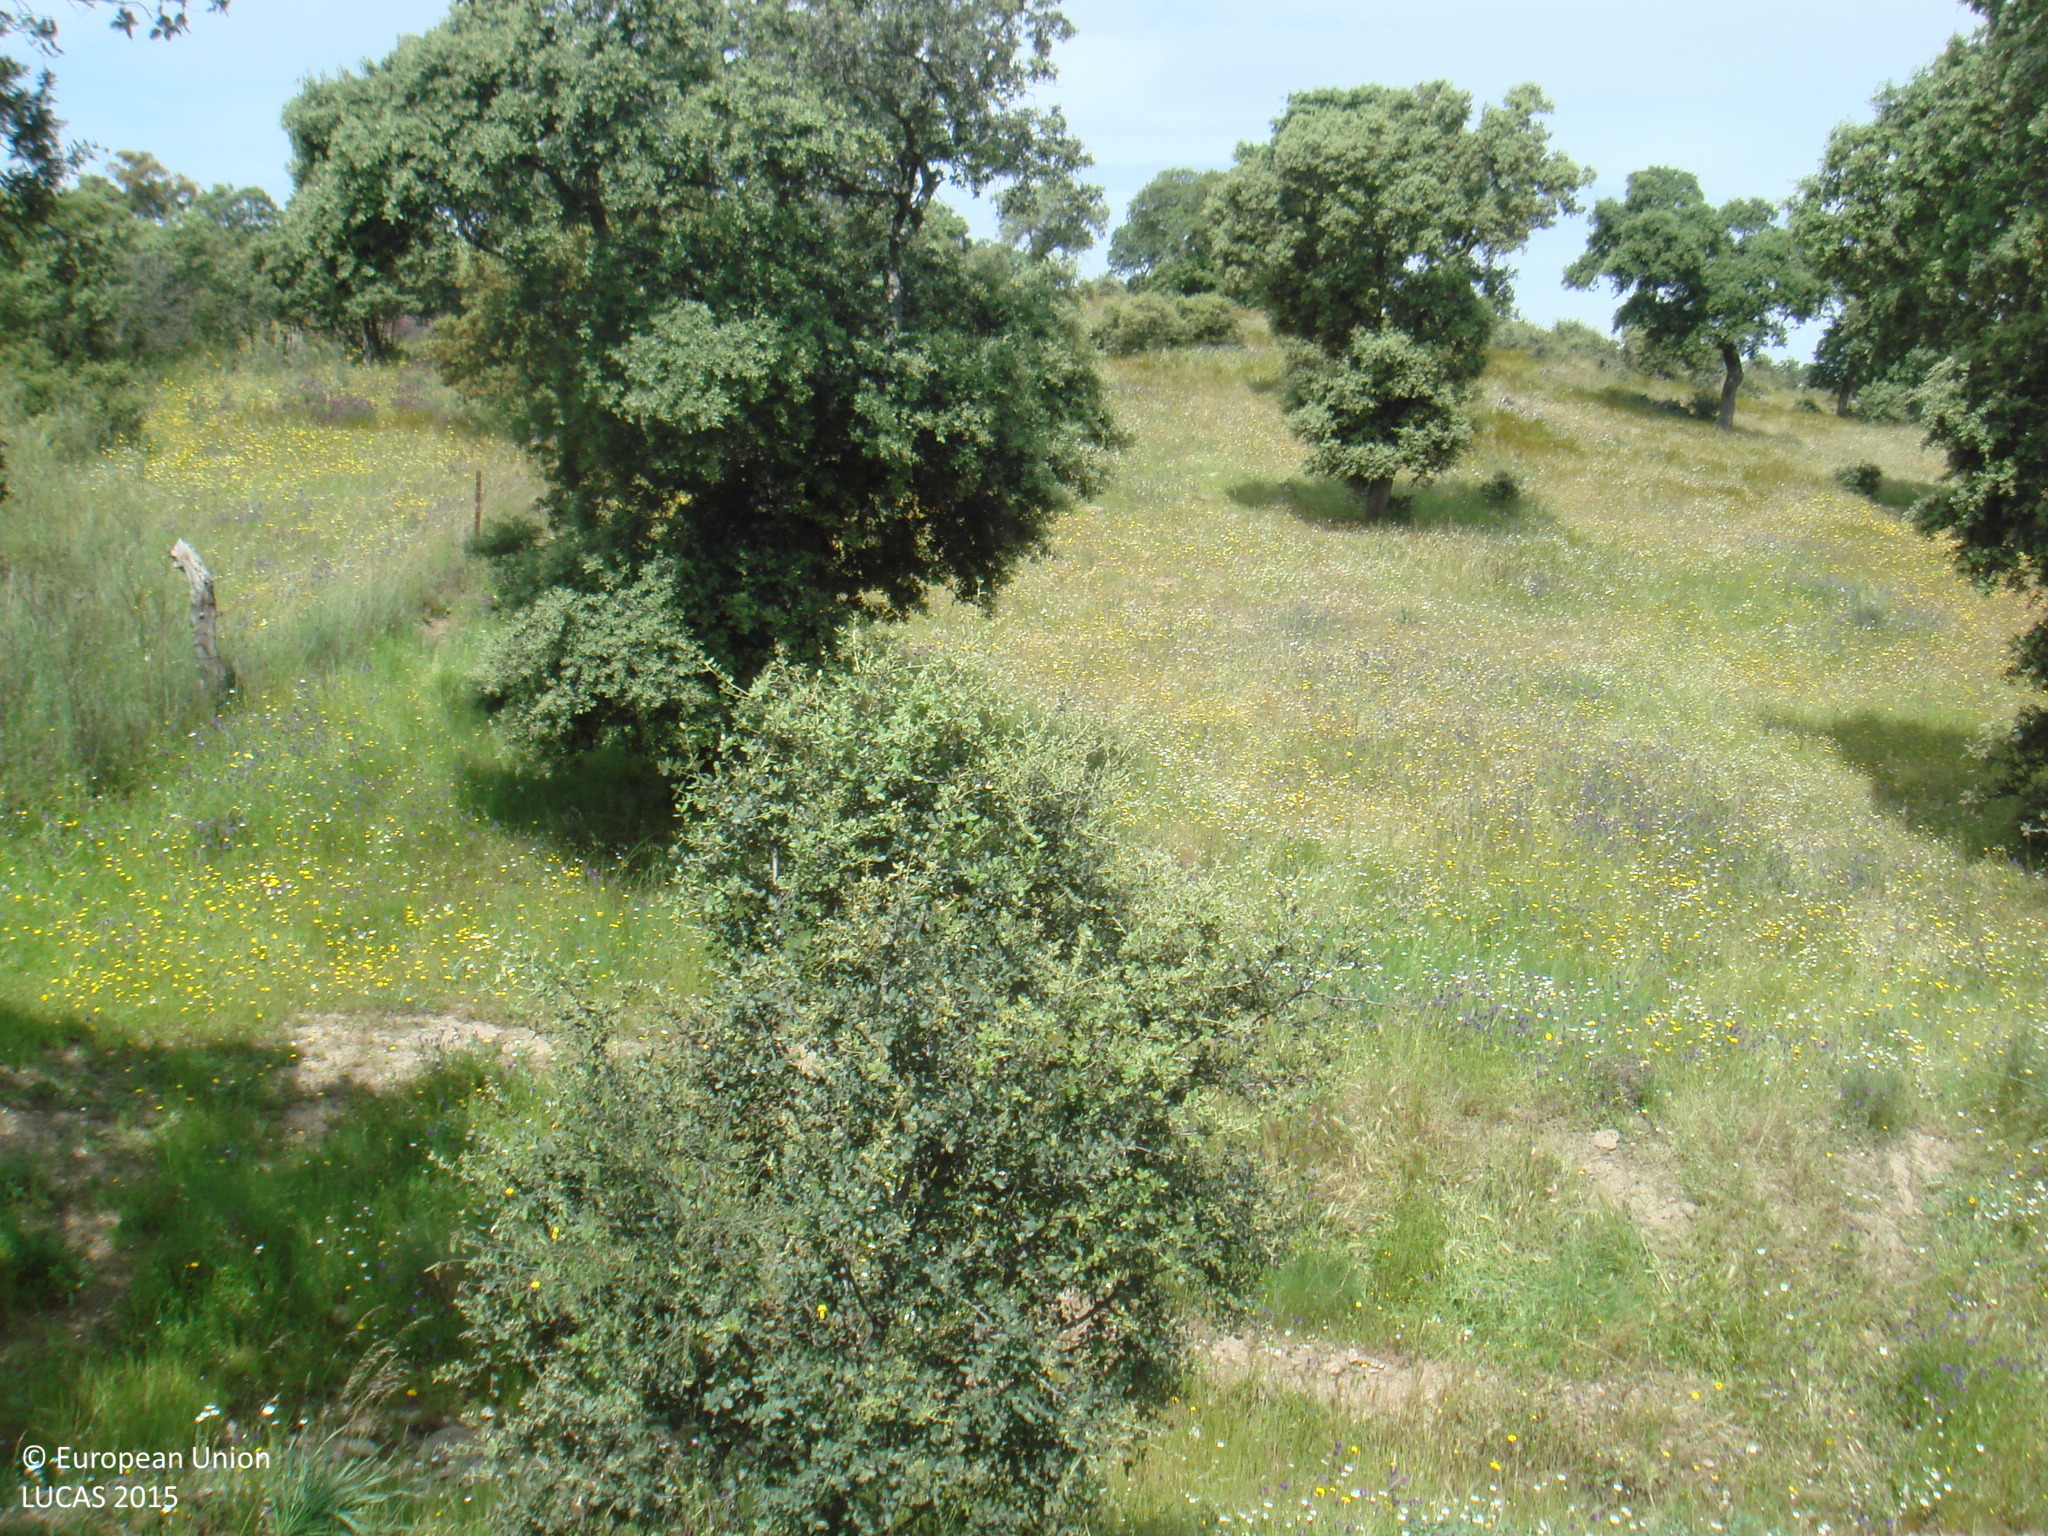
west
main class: Woodland
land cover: Broadleaved woodland
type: broadleaved evergreen forest
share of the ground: 25 - 50 %
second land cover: Spontaneously vegetated surfaces
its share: > 75 %
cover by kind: herbaceous plants 50 %, broadleaved forest trees 40 %, shrubs 10 %
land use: Forestry
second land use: Agriculture (excluding fallow land and kitchen gardens)
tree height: > 5 m
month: May
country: ES
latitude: 38.3988
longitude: -5.0612
